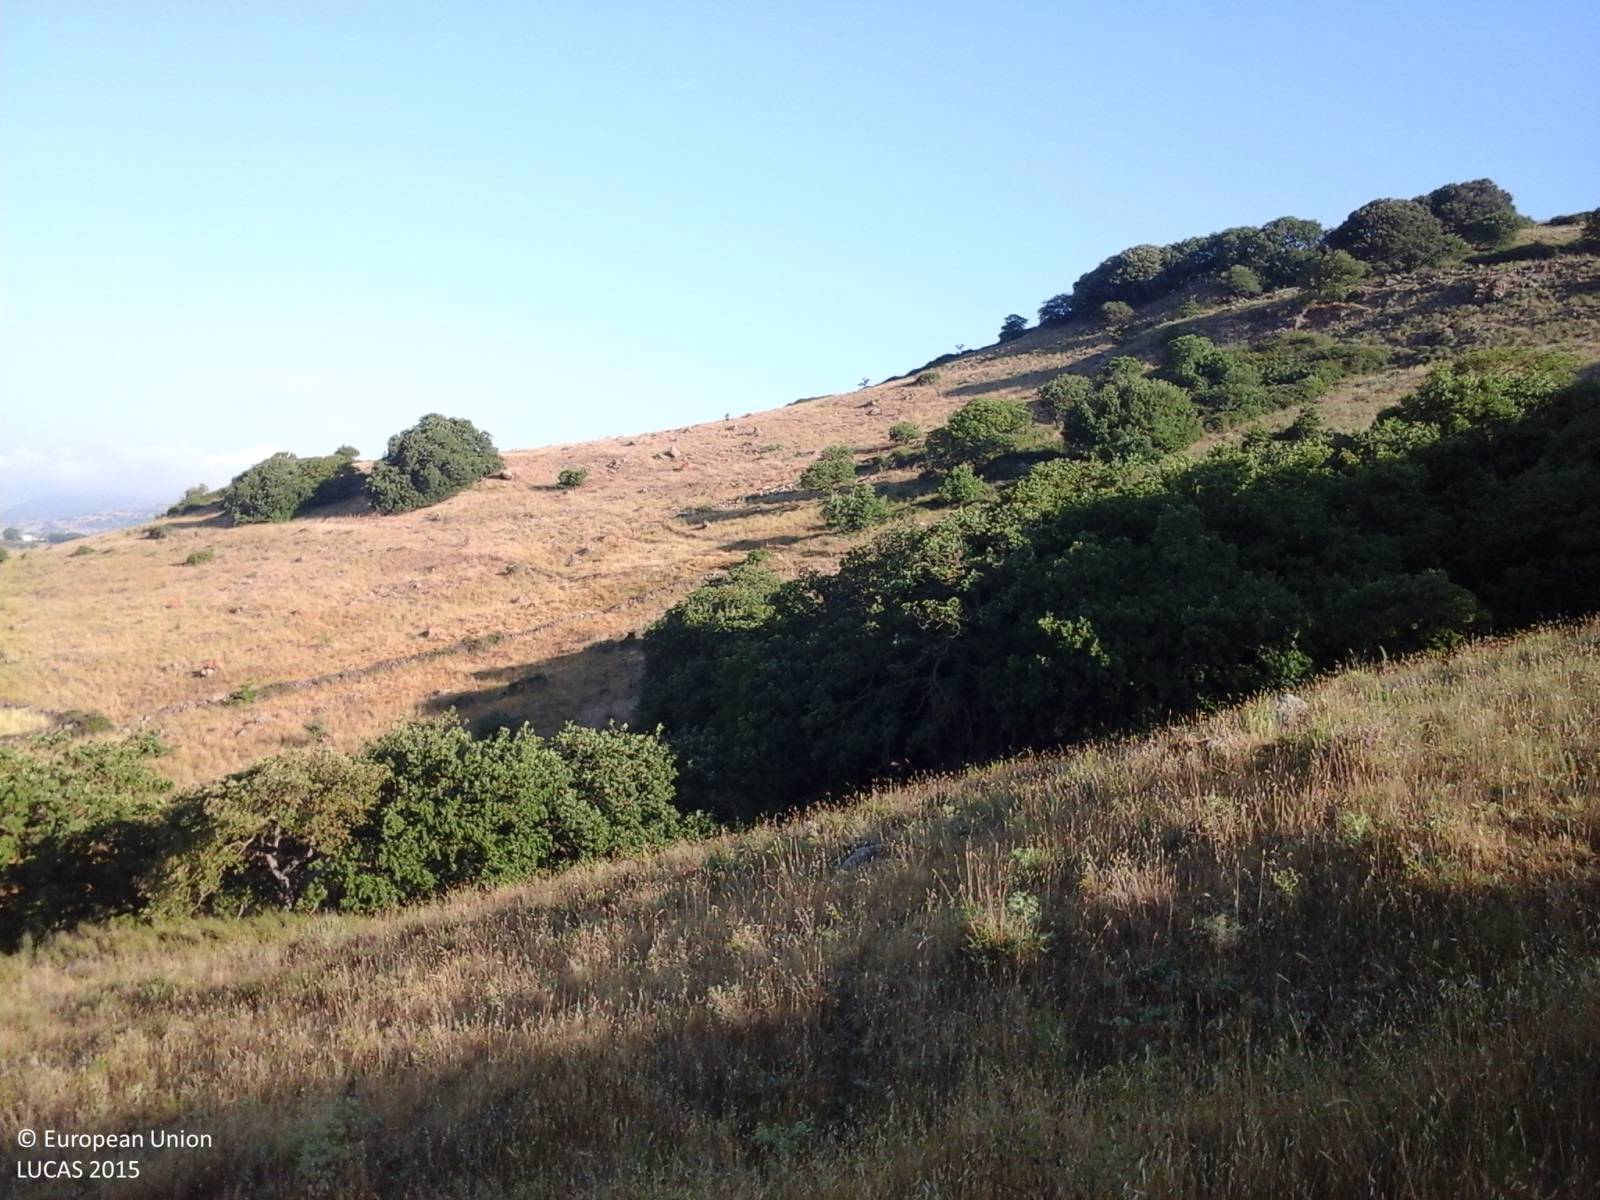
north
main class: Grassland
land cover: Grassland without tree/shrub cover
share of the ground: > 75 %
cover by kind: herbaceous plants 100 %
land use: Agriculture (excluding fallow land and kitchen gardens)
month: June
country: IT
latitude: 40.6936
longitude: 8.7399
